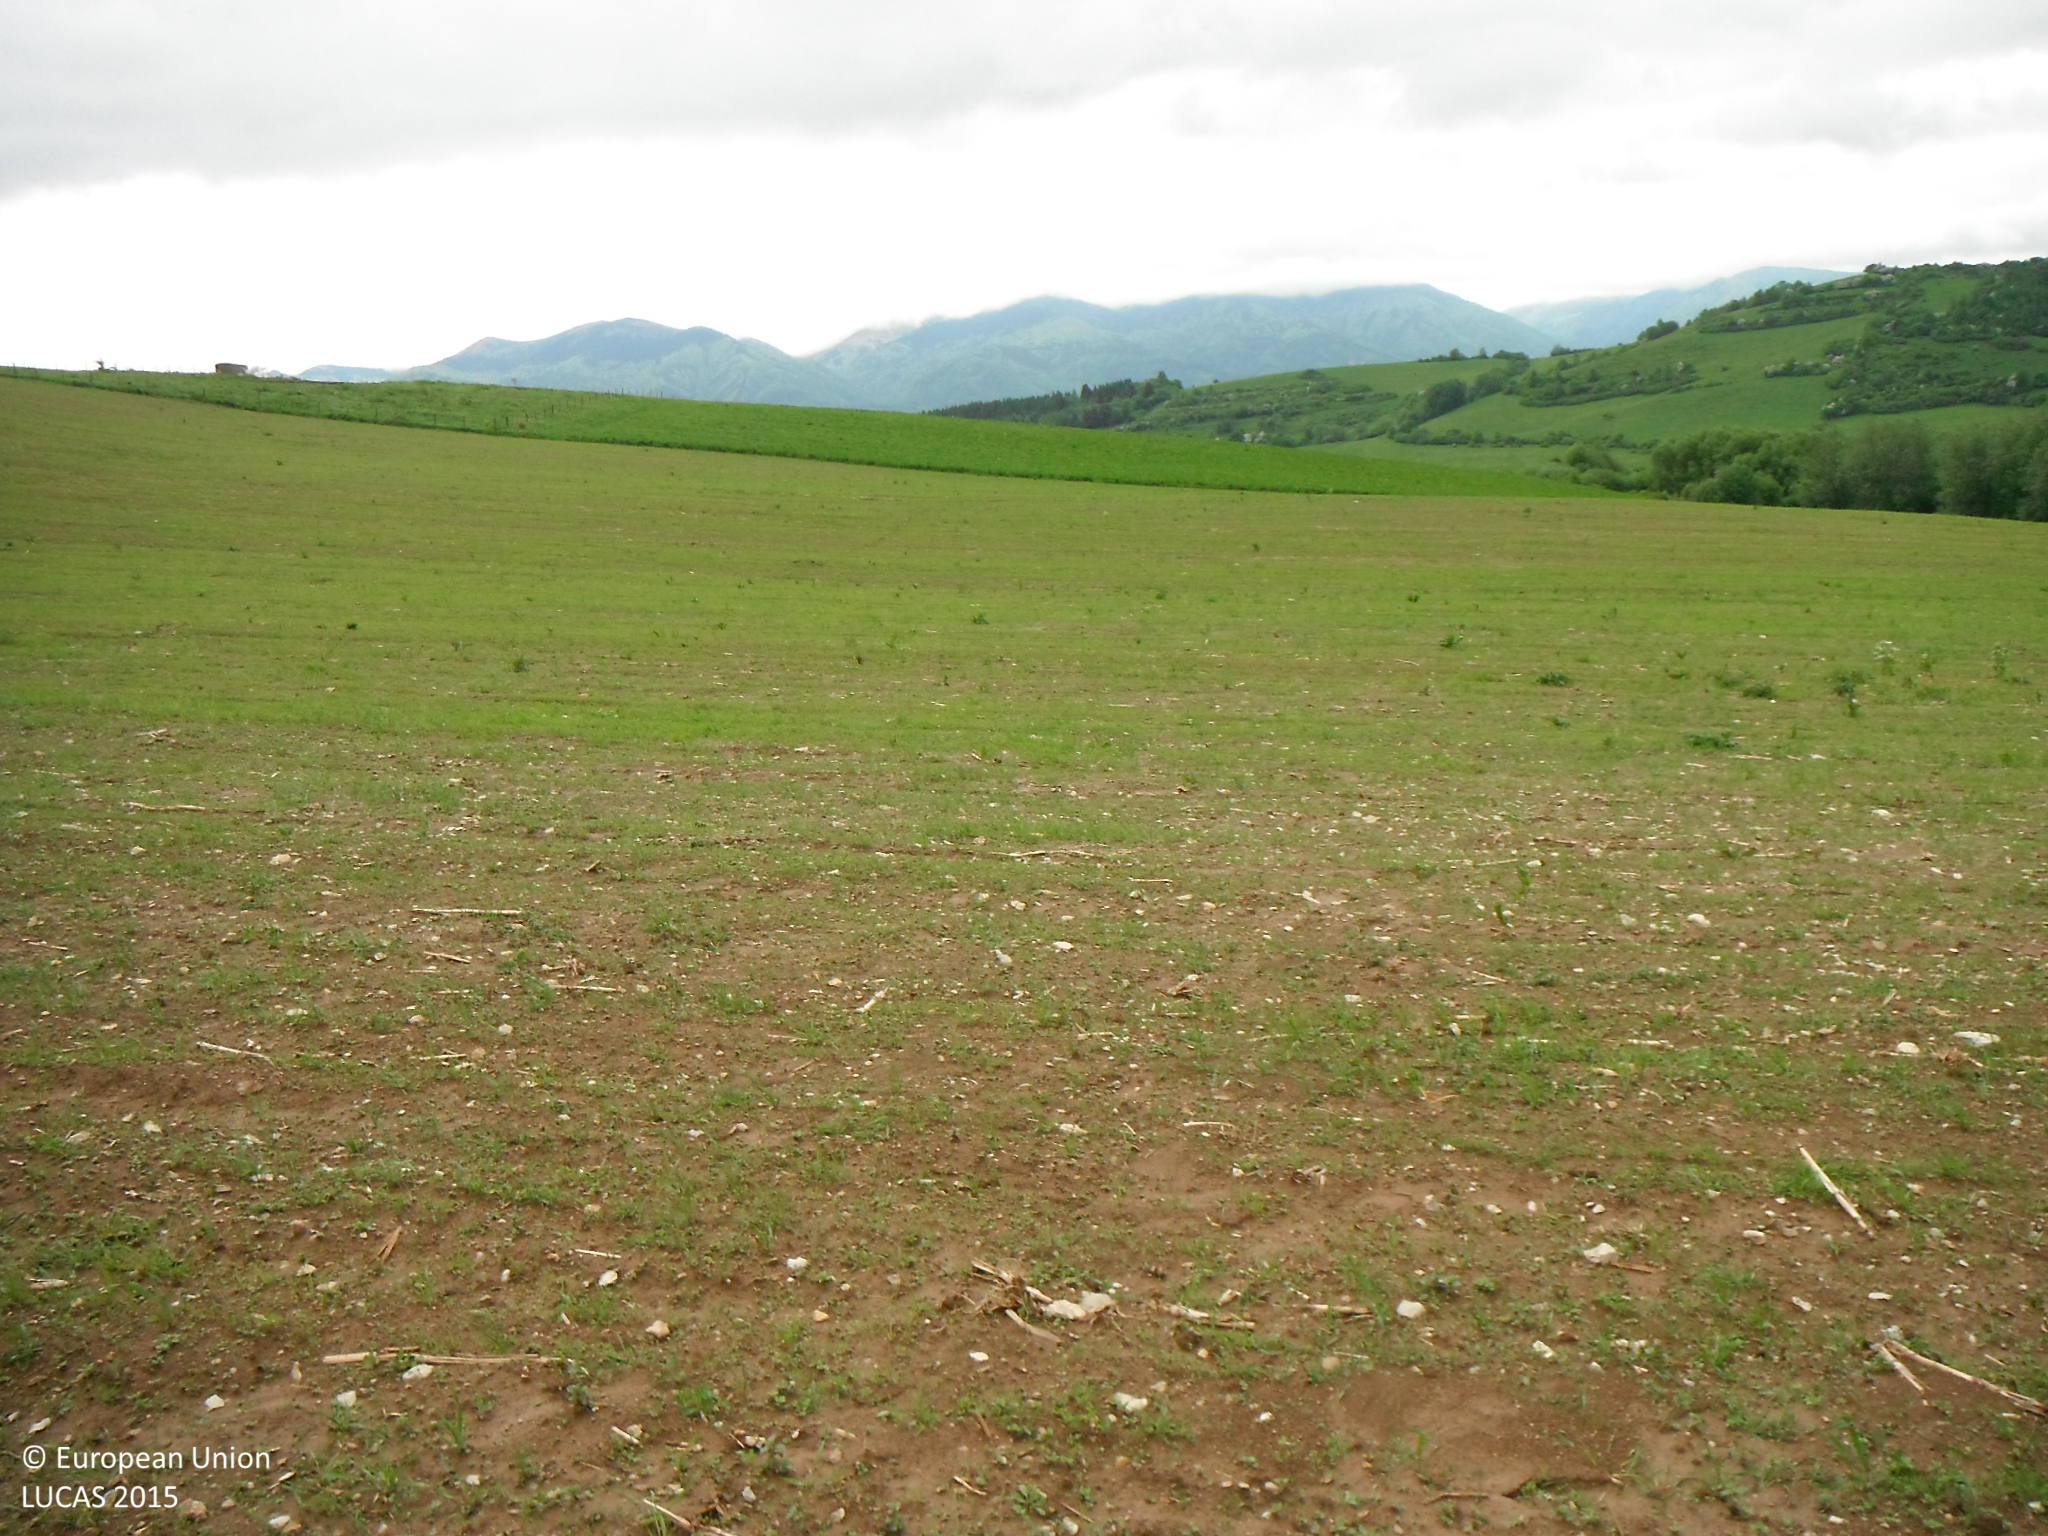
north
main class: Cropland
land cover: Common wheat
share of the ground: 25 - 50 %
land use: Agriculture (excluding fallow land and kitchen gardens)
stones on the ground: 10 - 25 %
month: May
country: SK
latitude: 49.0821
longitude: 19.0448
